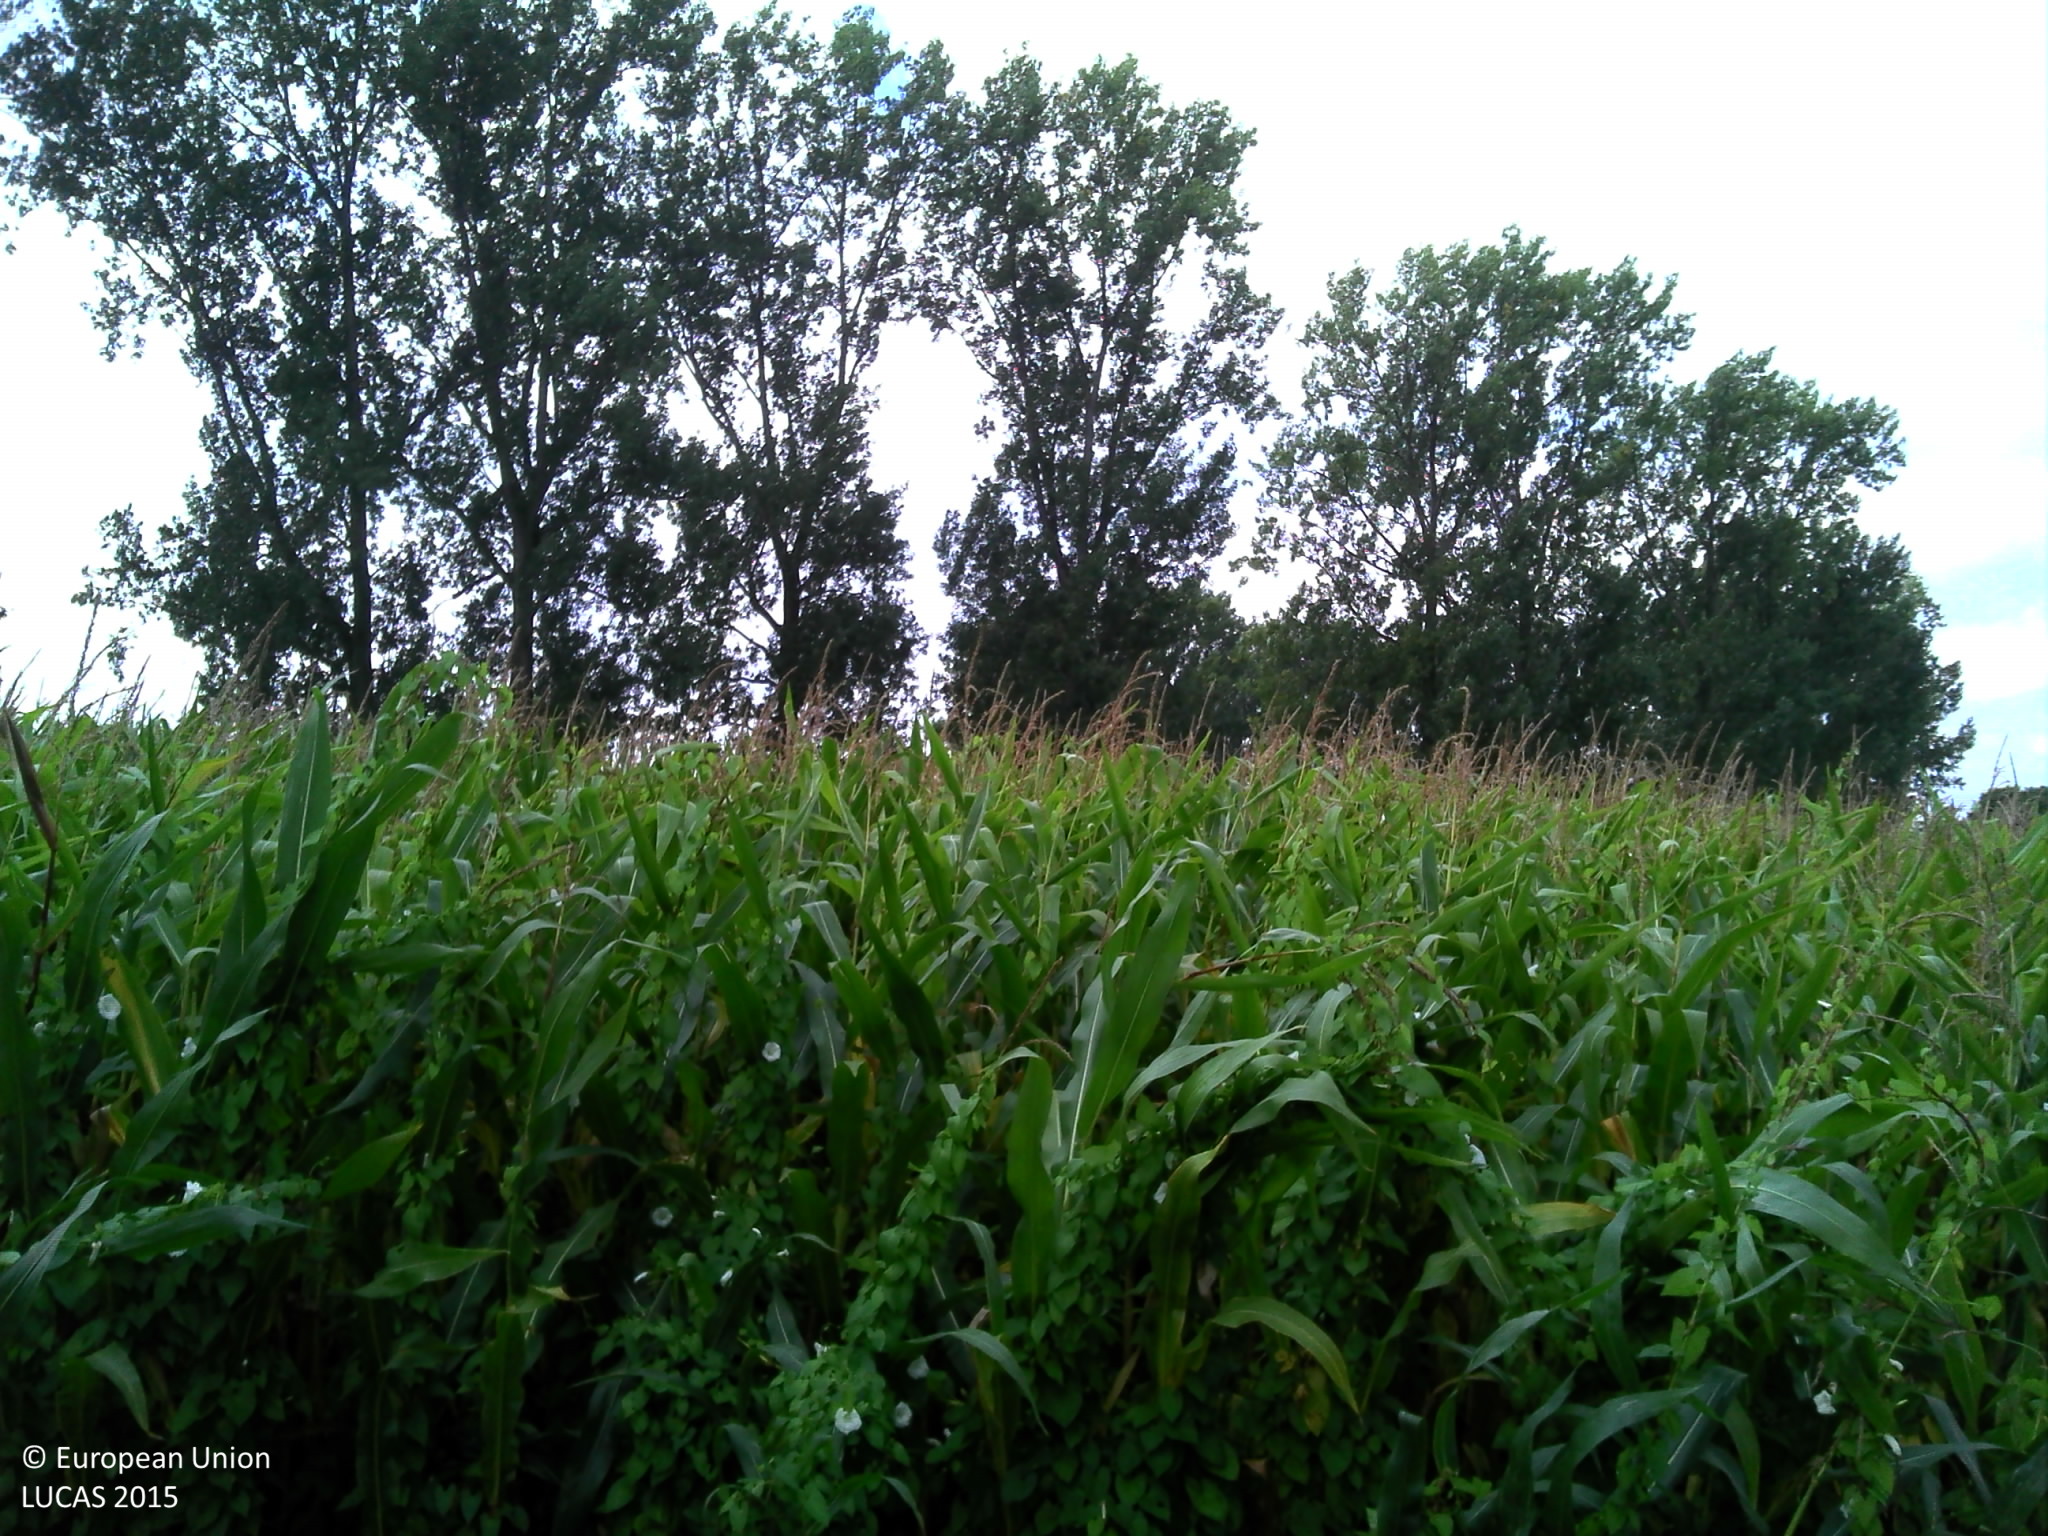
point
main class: Cropland
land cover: Maize
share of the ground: > 75 %
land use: Agriculture (excluding fallow land and kitchen gardens)
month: September
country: BE
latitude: 51.1464
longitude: 4.4062
